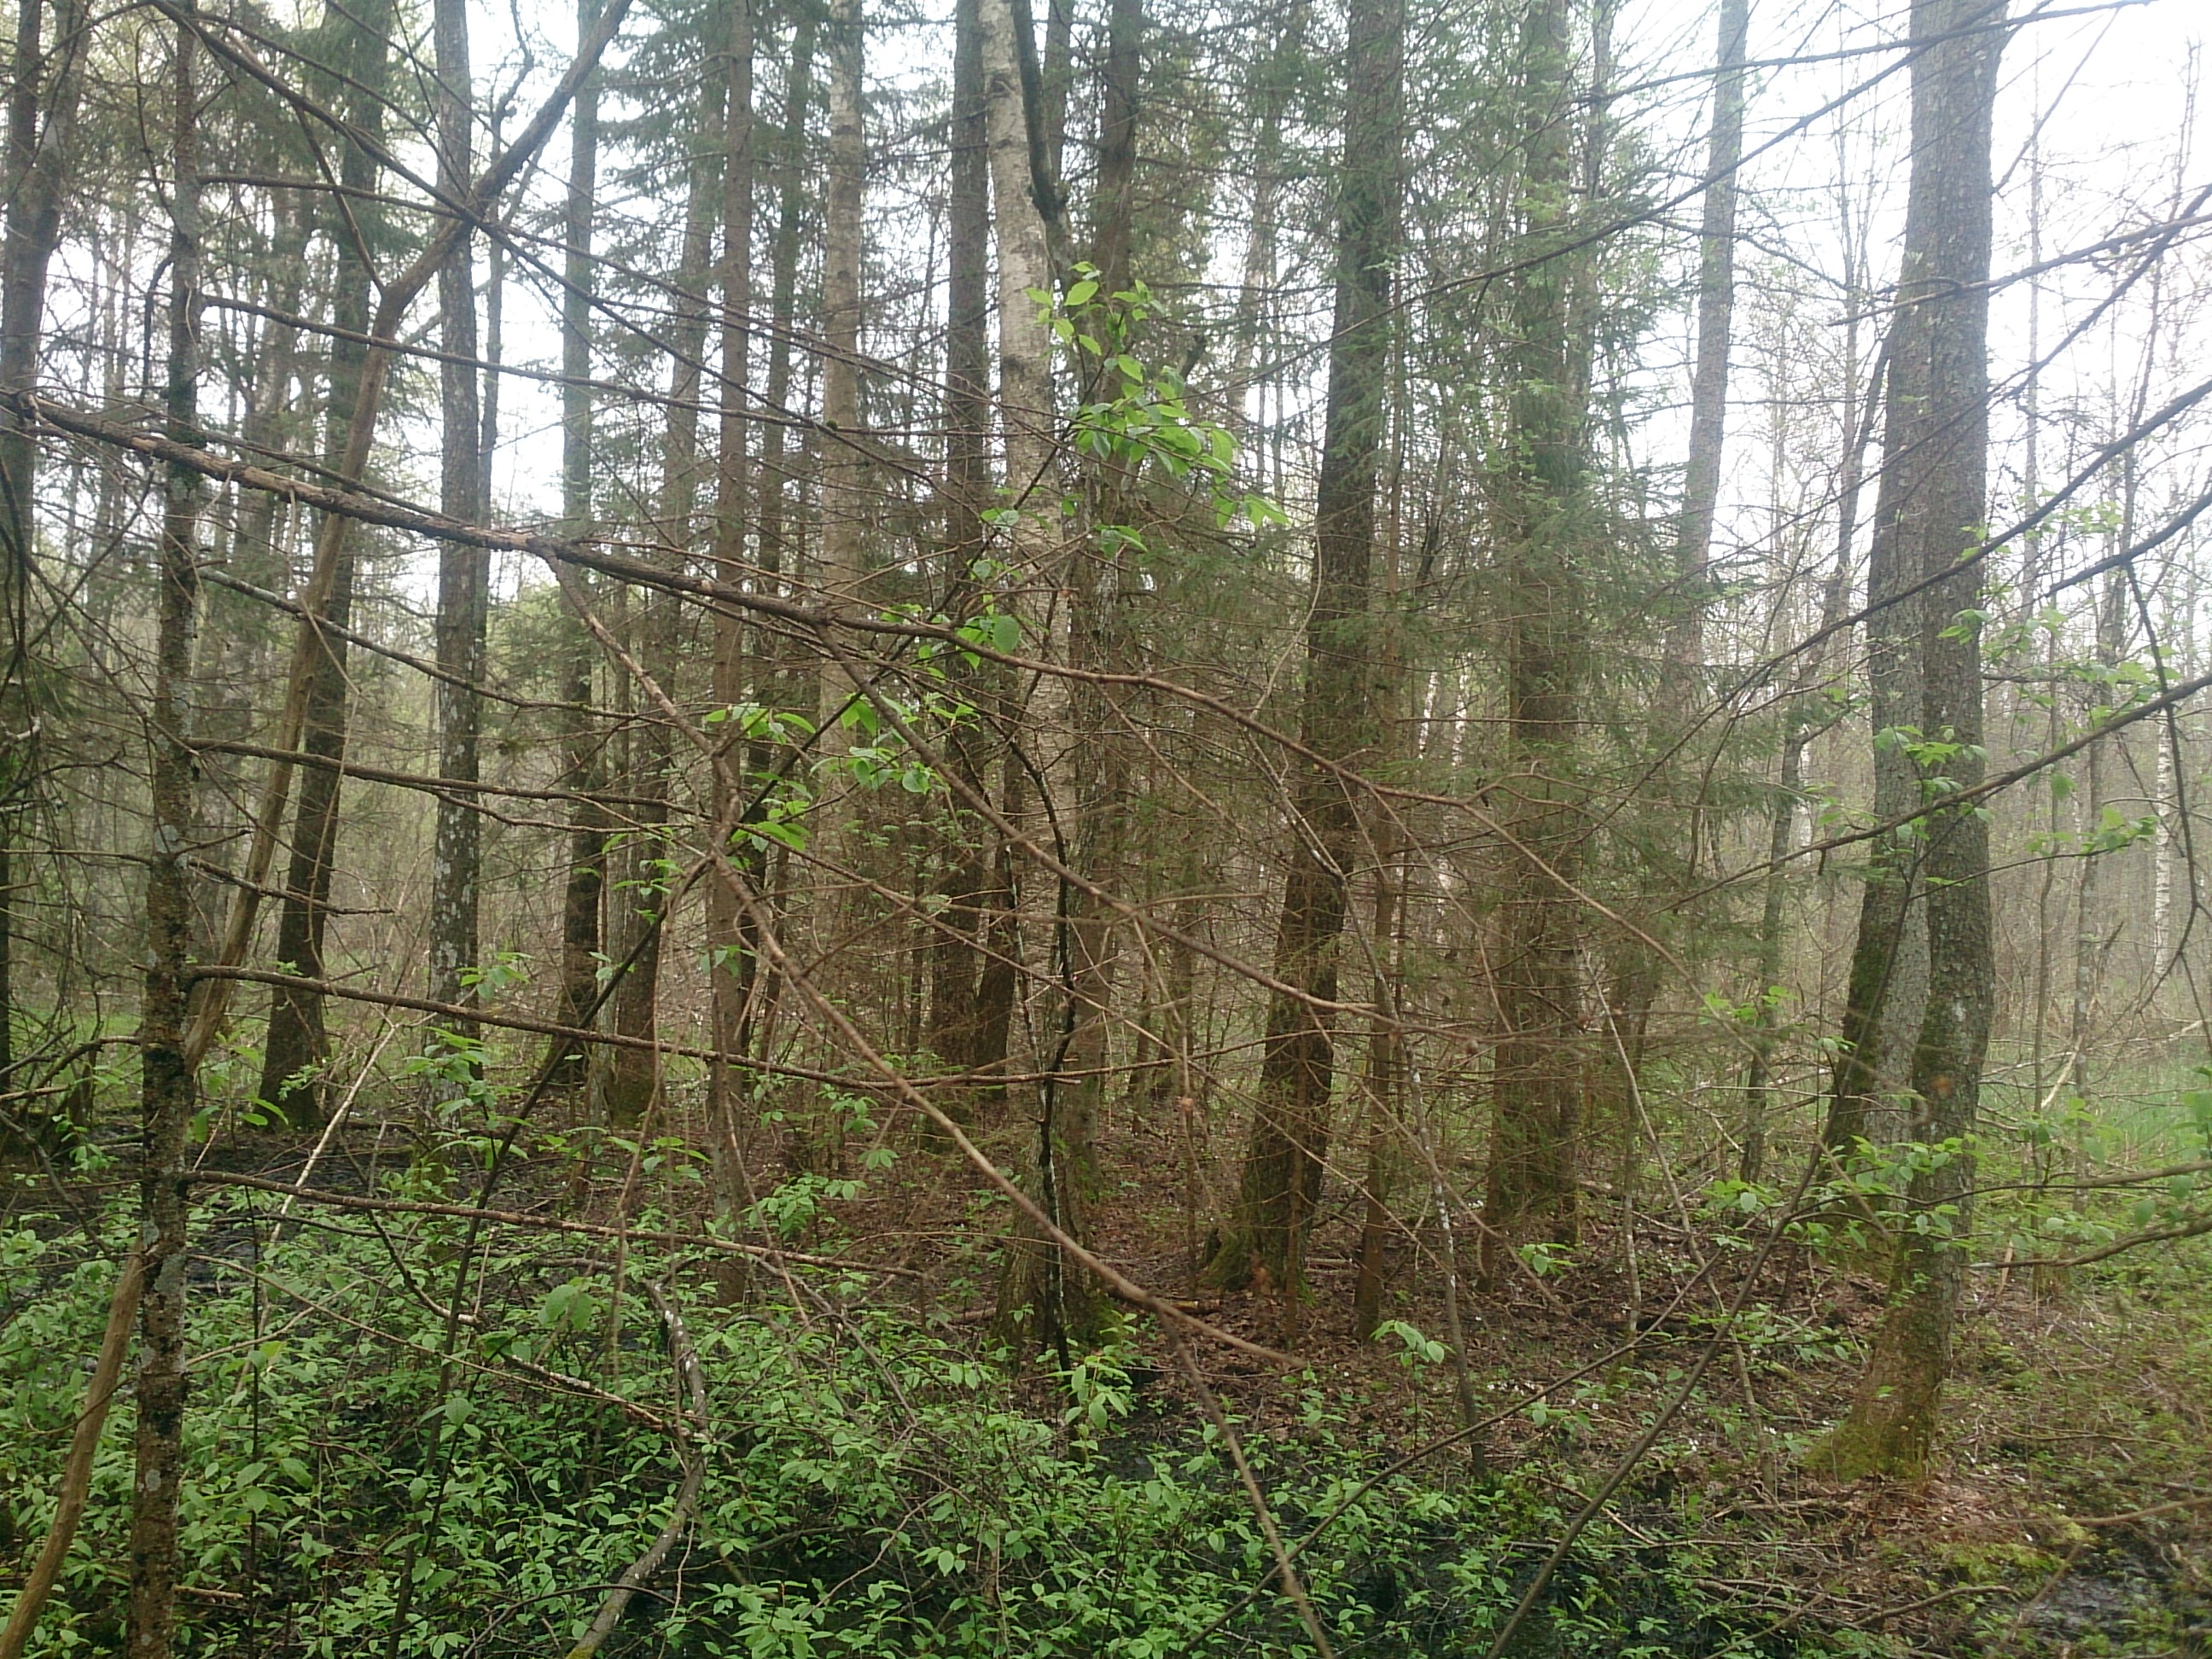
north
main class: Woodland
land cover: Spruce dominated mixed woodland
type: hemiboreal forest and nemoral coniferous forest and mixed broadleaved-coniferous forest
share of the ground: > 75 %
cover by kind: coniferous forest trees 50 %, broadleaved forest trees 50 %
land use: Forestry
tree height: > 5 m
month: May
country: LV
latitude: 56.7040
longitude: 24.2504
